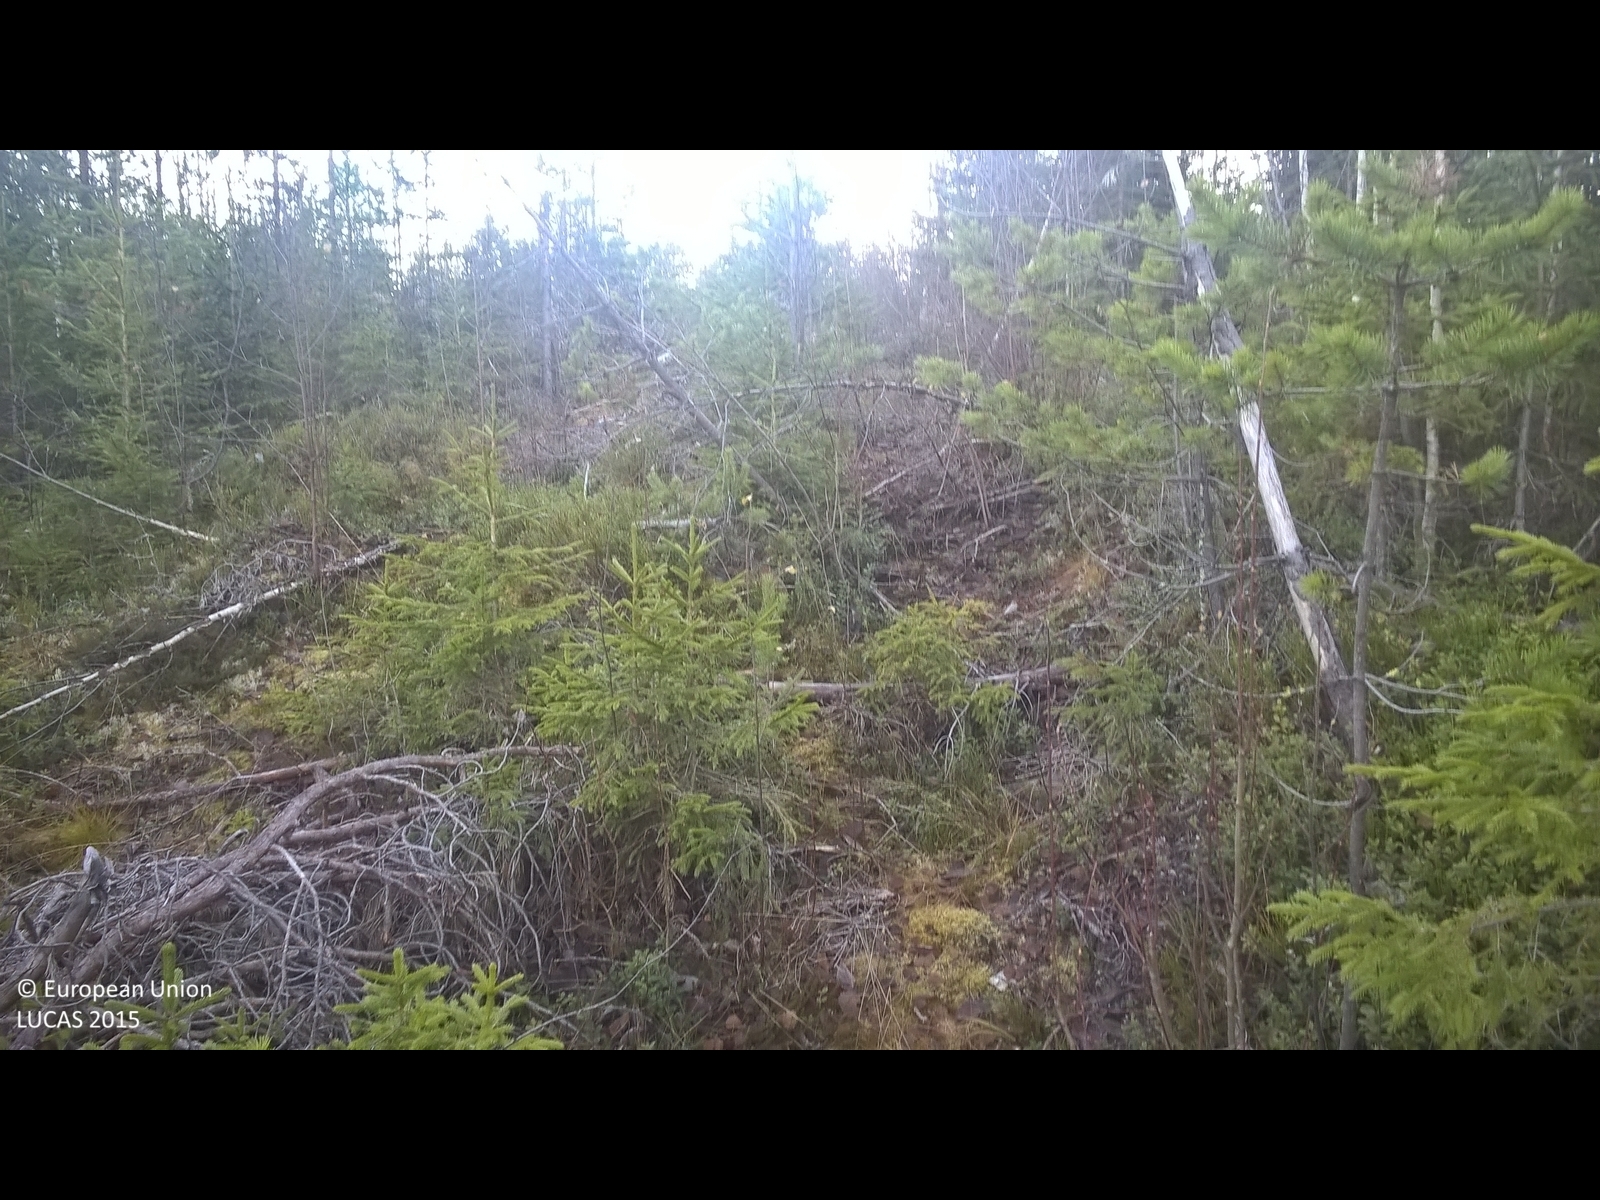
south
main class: Woodland
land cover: Other mixed woodland
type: boreal forest
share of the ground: 50 - 75 %
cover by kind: coniferous forest trees 40 %, lichens and mosses 40 %, broadleaved forest trees 20 %
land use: Forestry
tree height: < 5 m
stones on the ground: < 10 %
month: October
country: SE
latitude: 63.0803
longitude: 15.7775
